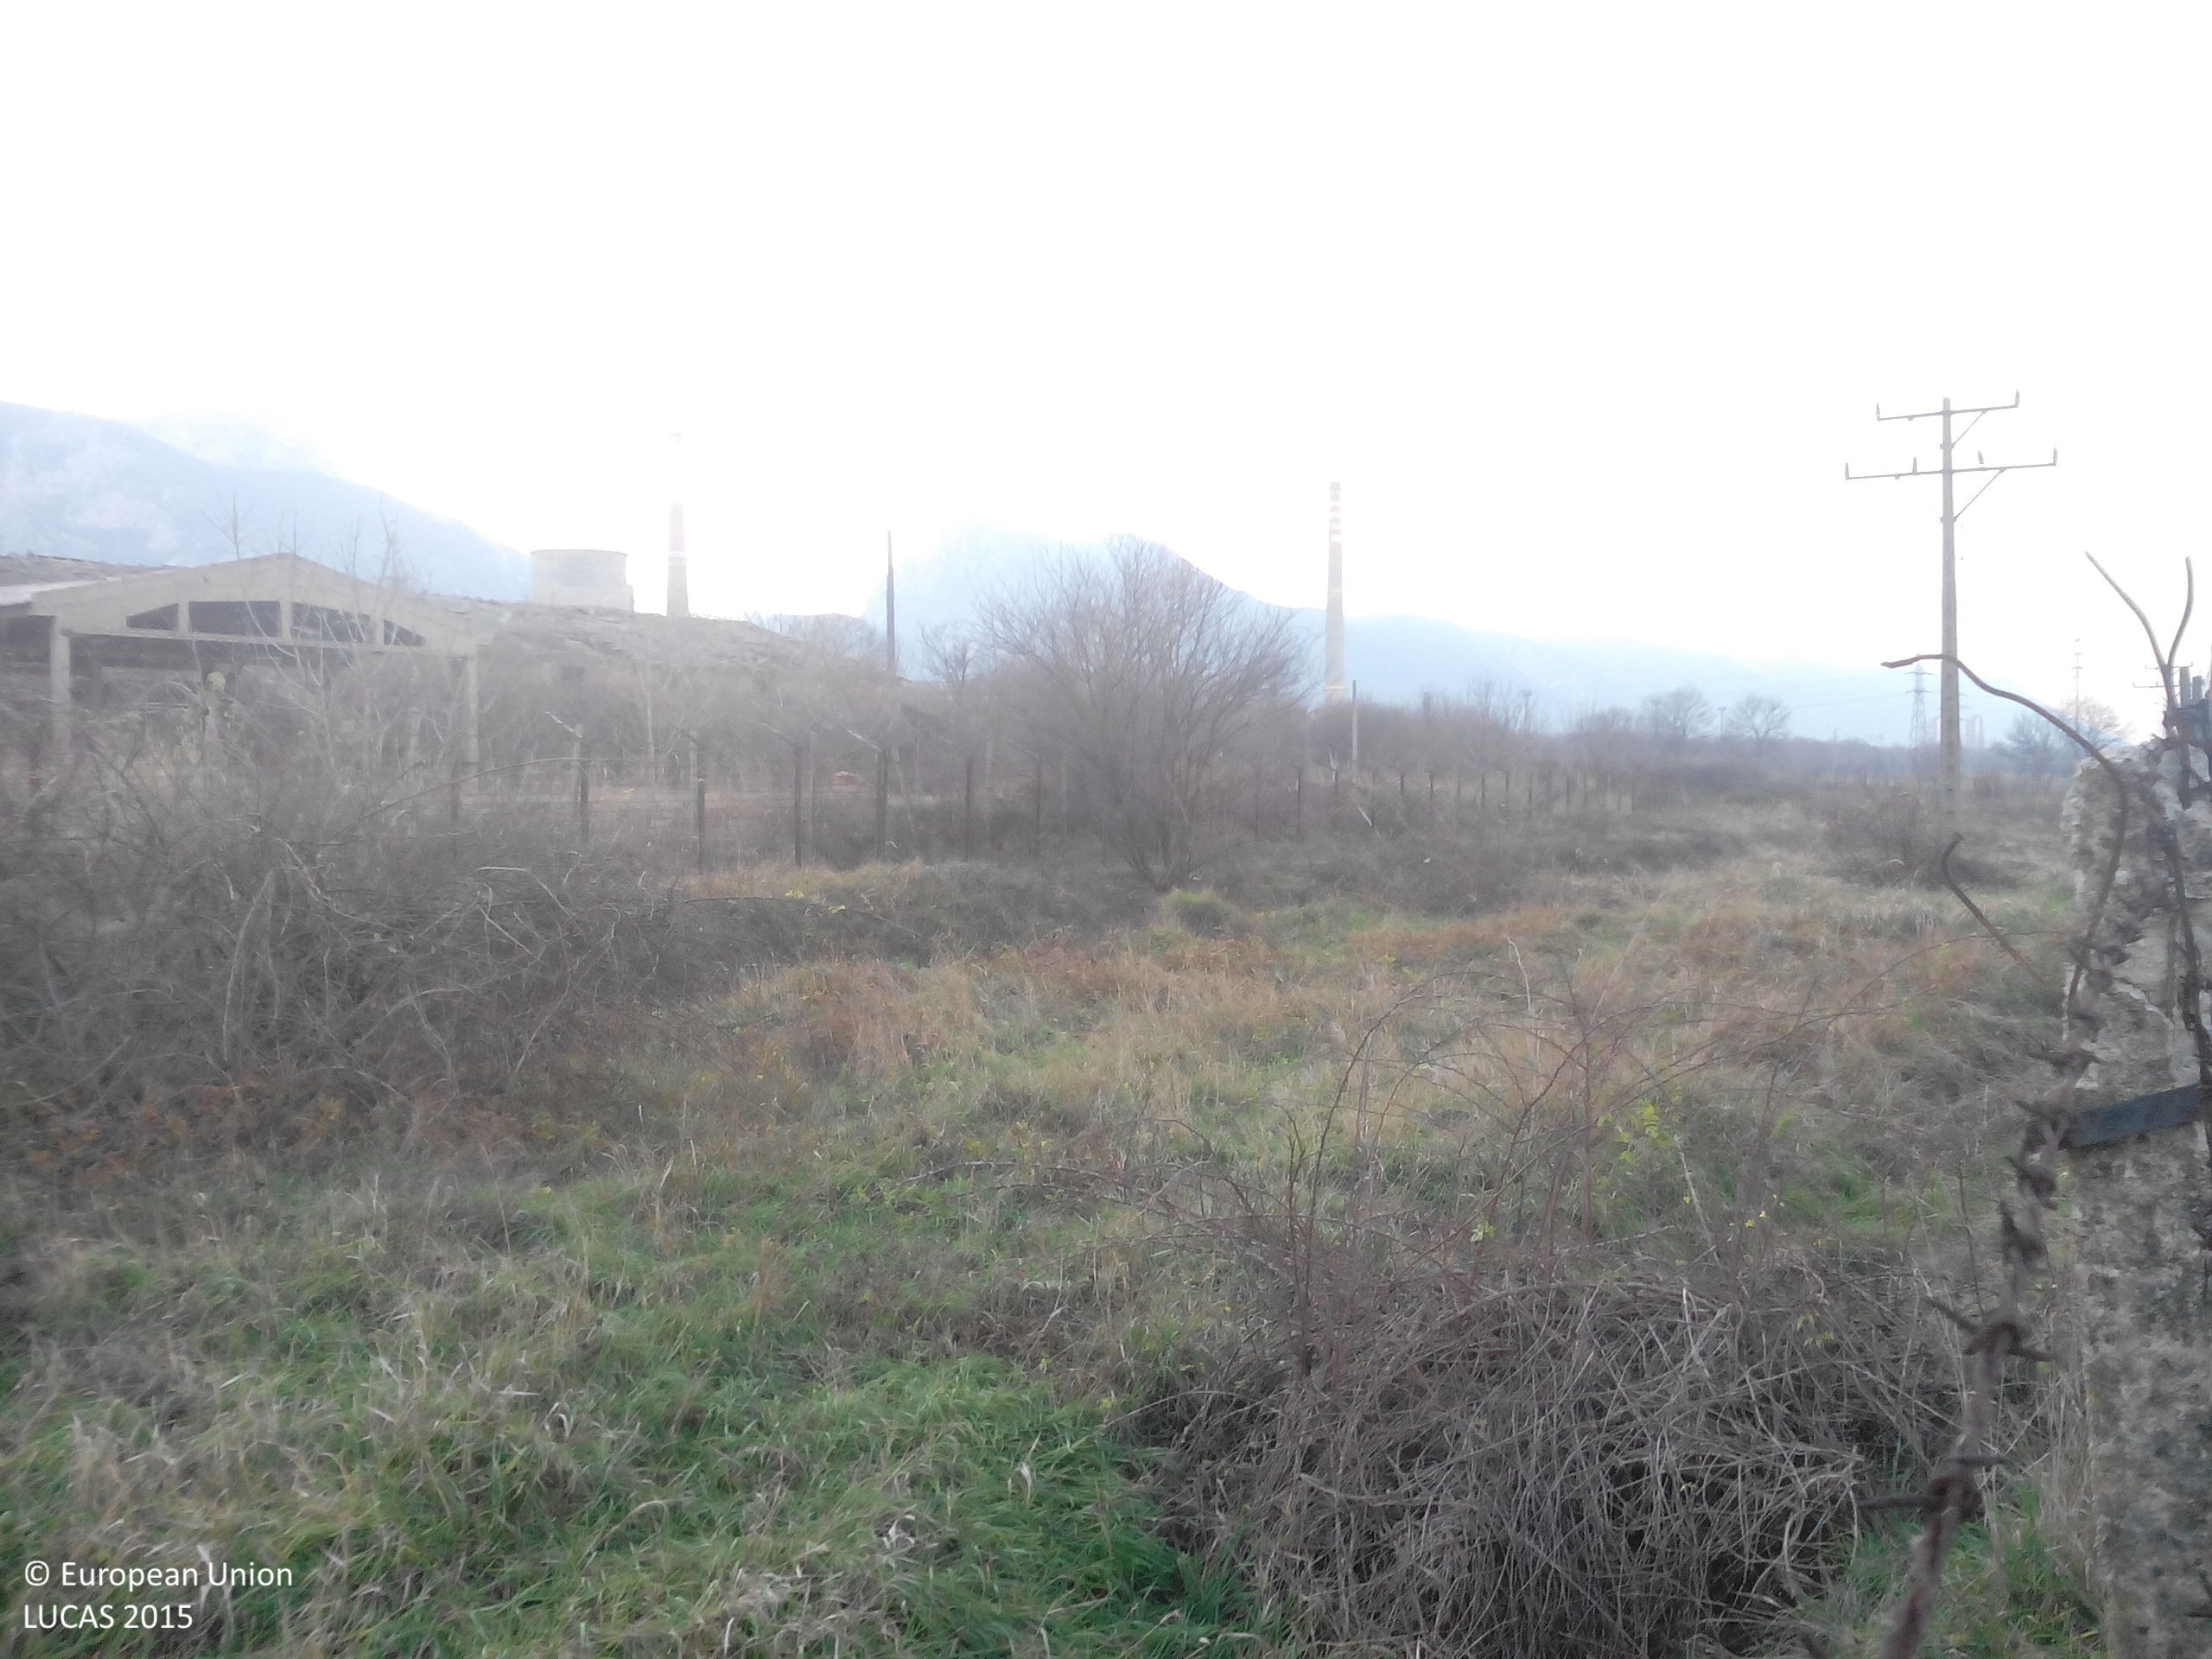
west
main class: Woodland
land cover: Broadleaved woodland
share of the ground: 25 - 50 %
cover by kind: shrubs 45 %, herbaceous plants 25 %, broadleaved forest trees 20 %, unconsolidated bare surface 10 %
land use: Machinery and equipment
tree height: < 5 m
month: December
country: BG
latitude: 43.1957
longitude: 23.5919
